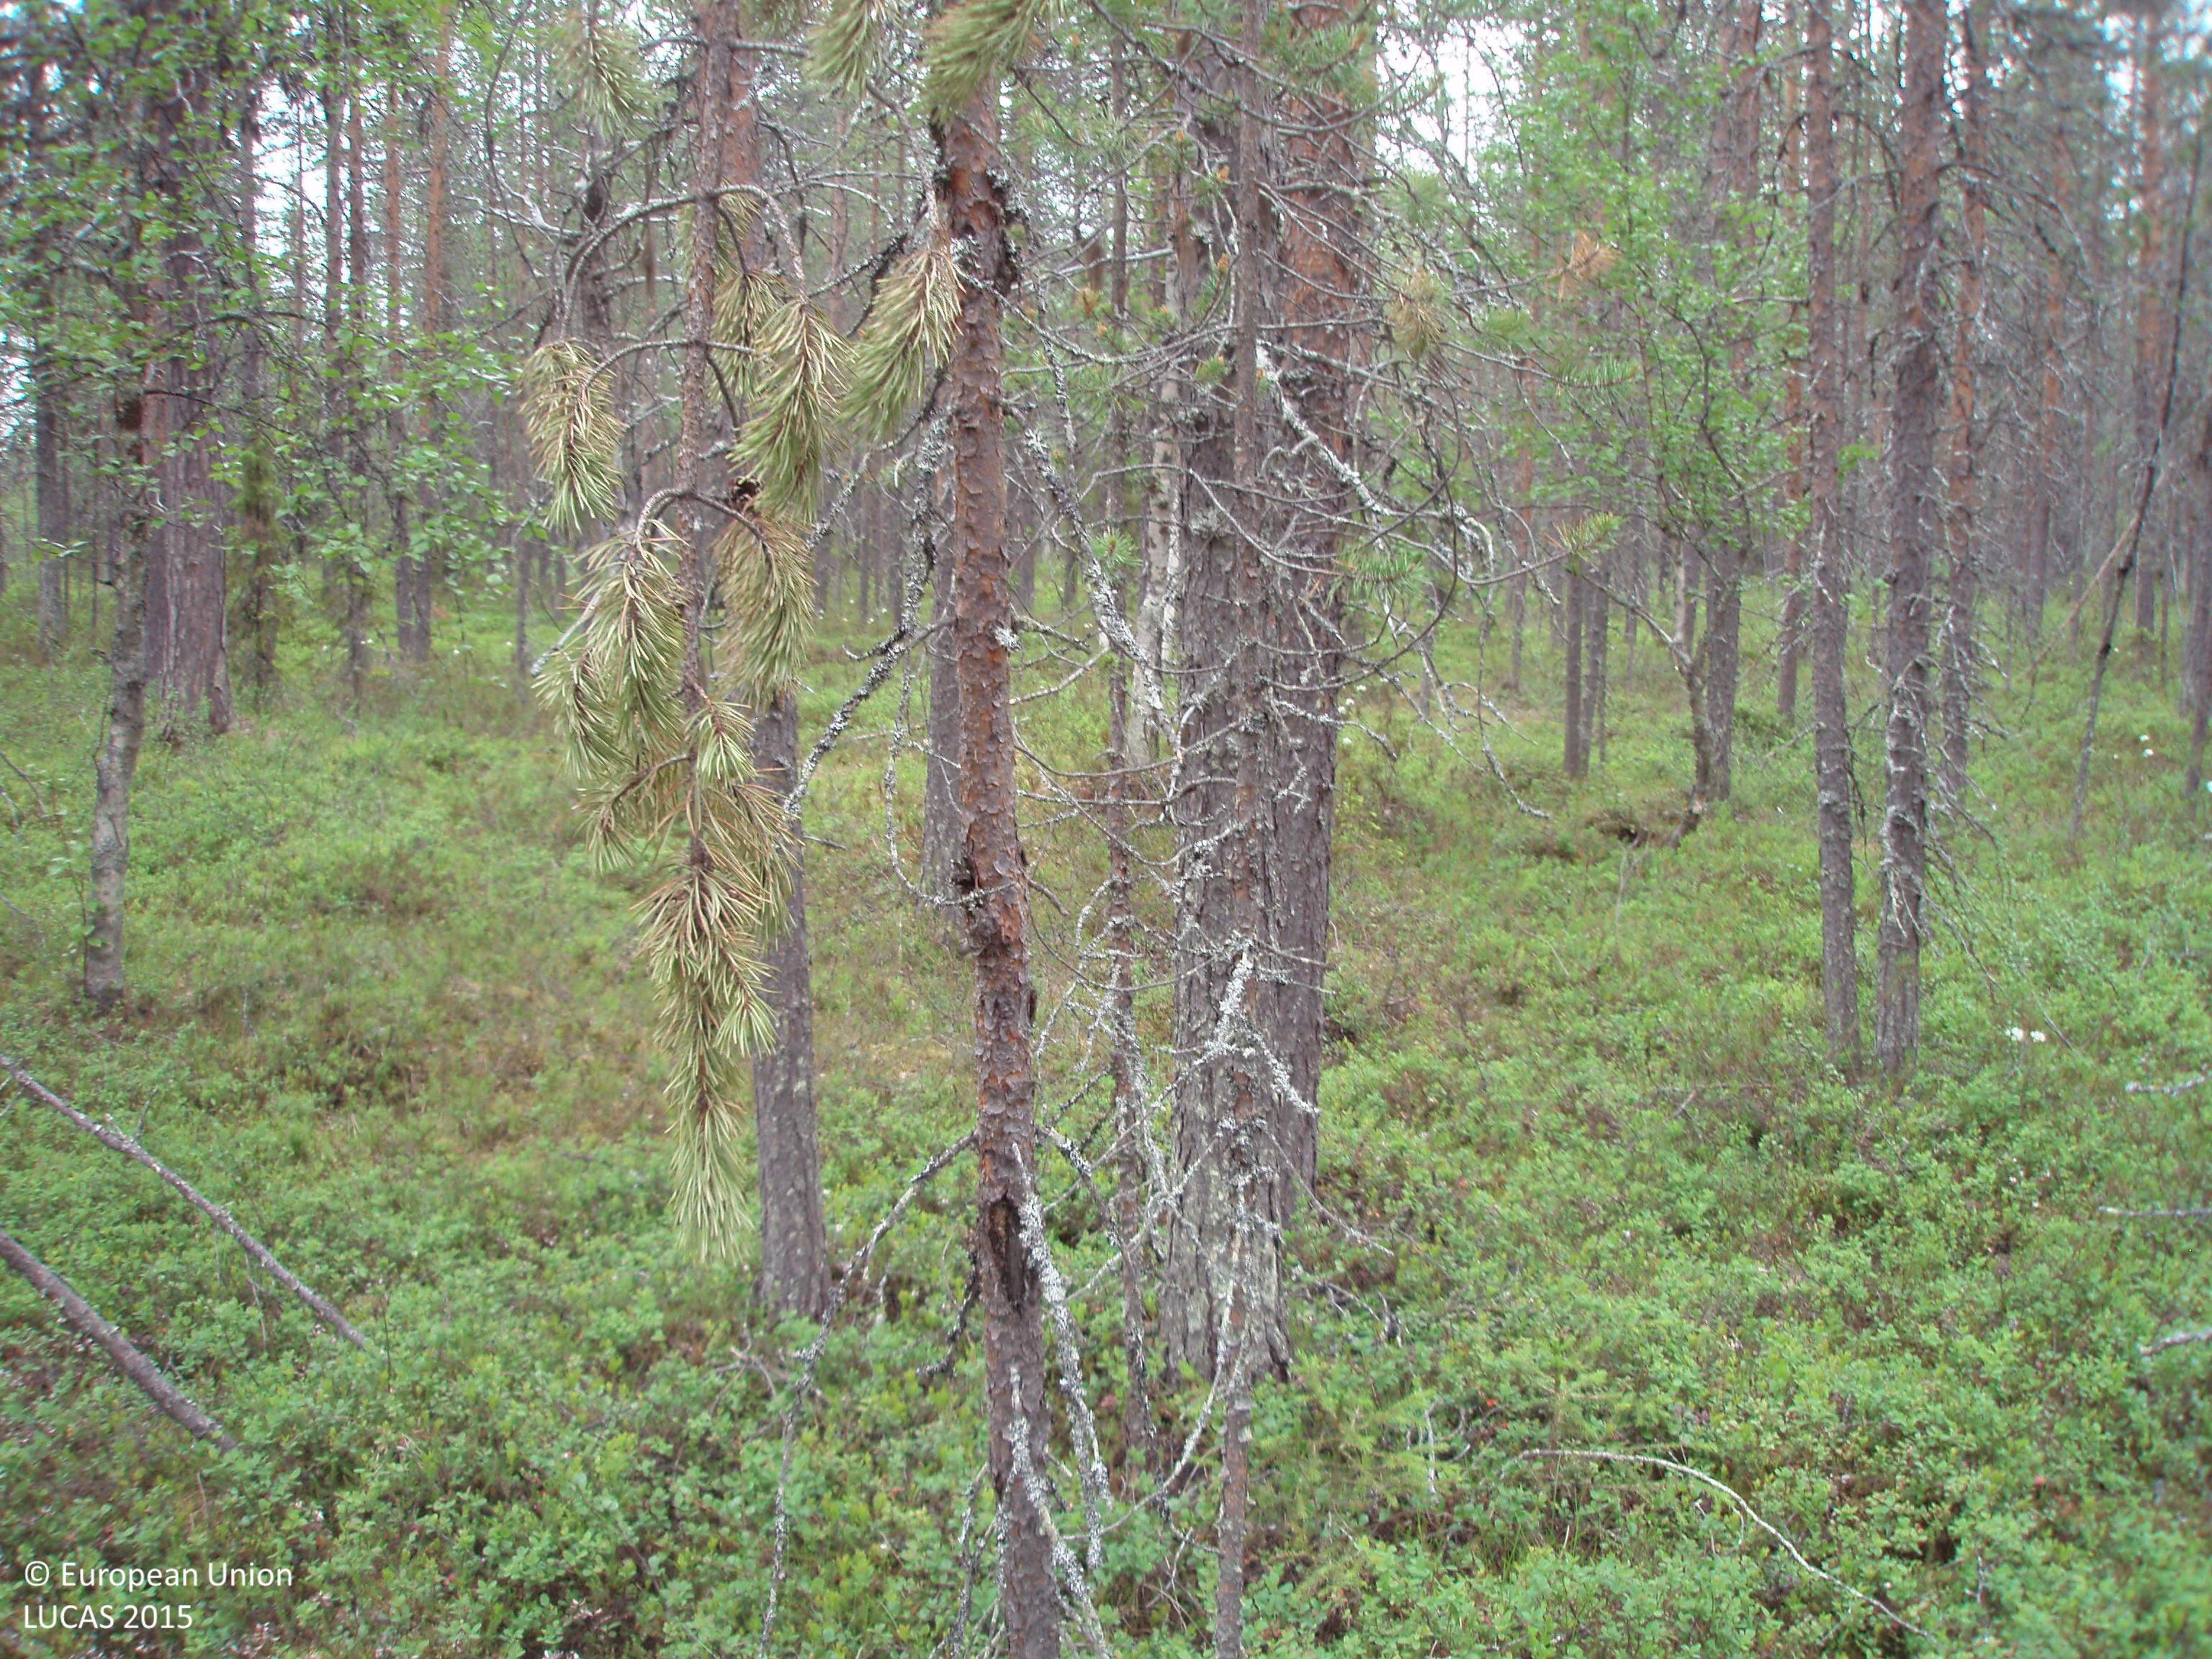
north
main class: Woodland
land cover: Pine dominated coniferous woodland
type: boreal forest
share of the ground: > 75 %
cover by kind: coniferous forest trees 75 %, shrubs 25 %
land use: Forestry
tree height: > 5 m
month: July
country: FI
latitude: 67.5615
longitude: 28.5104
